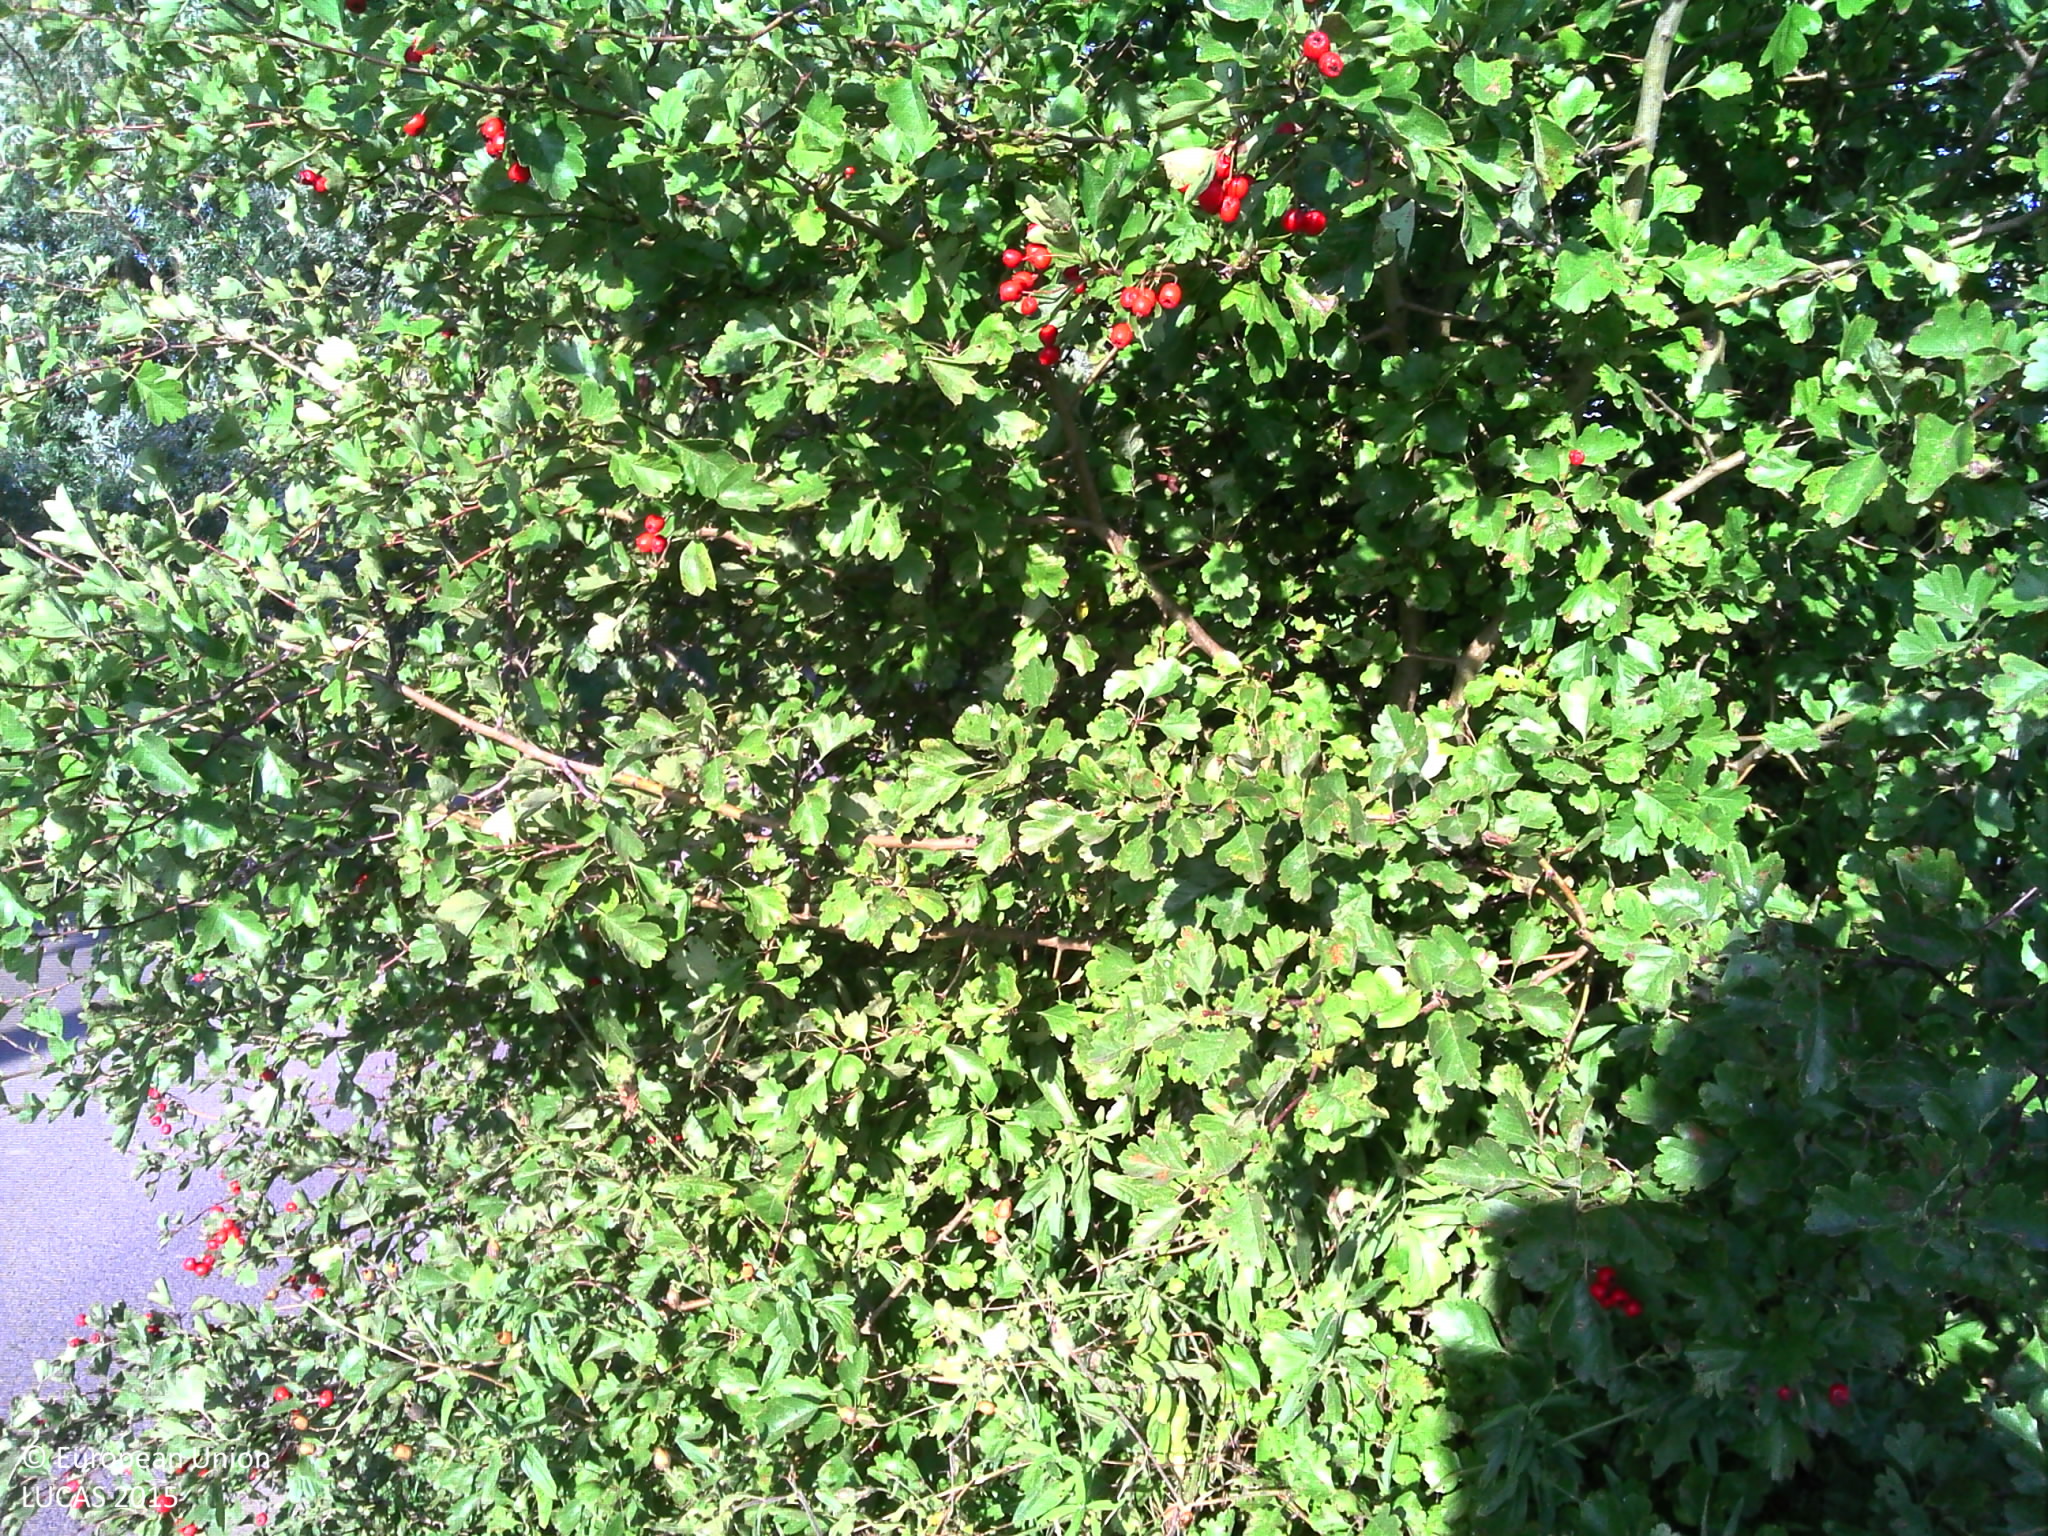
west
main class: Grassland
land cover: Grassland without tree/shrub cover
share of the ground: > 75 %
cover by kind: herbaceous plants 100 %
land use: Agriculture (excluding fallow land and kitchen gardens)
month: September
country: BE
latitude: 51.1247
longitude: 2.7157
